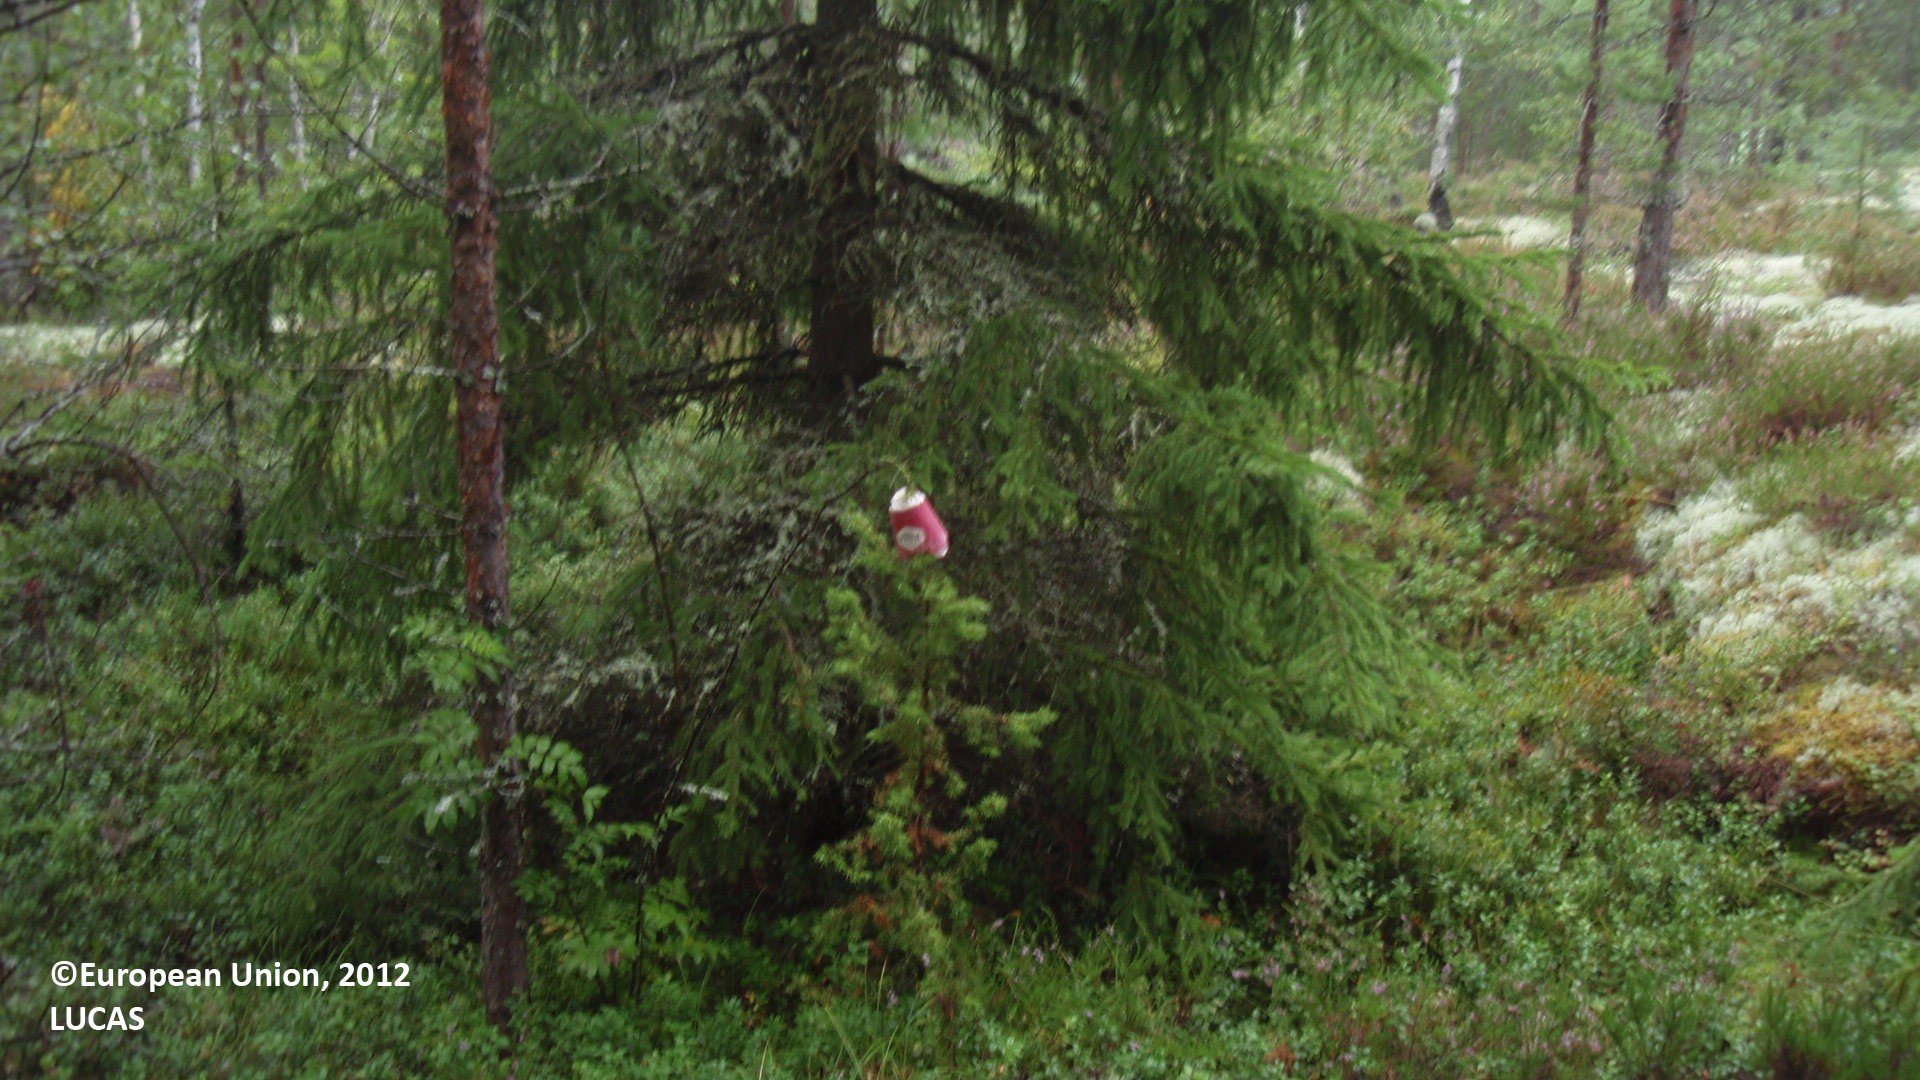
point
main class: Woodland
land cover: Pine dominated mixed woodland
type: boreal forest
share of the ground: 50 - 75 %
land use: Forestry
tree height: > 5 m
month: August
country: FI
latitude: 60.8547
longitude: 26.8586
